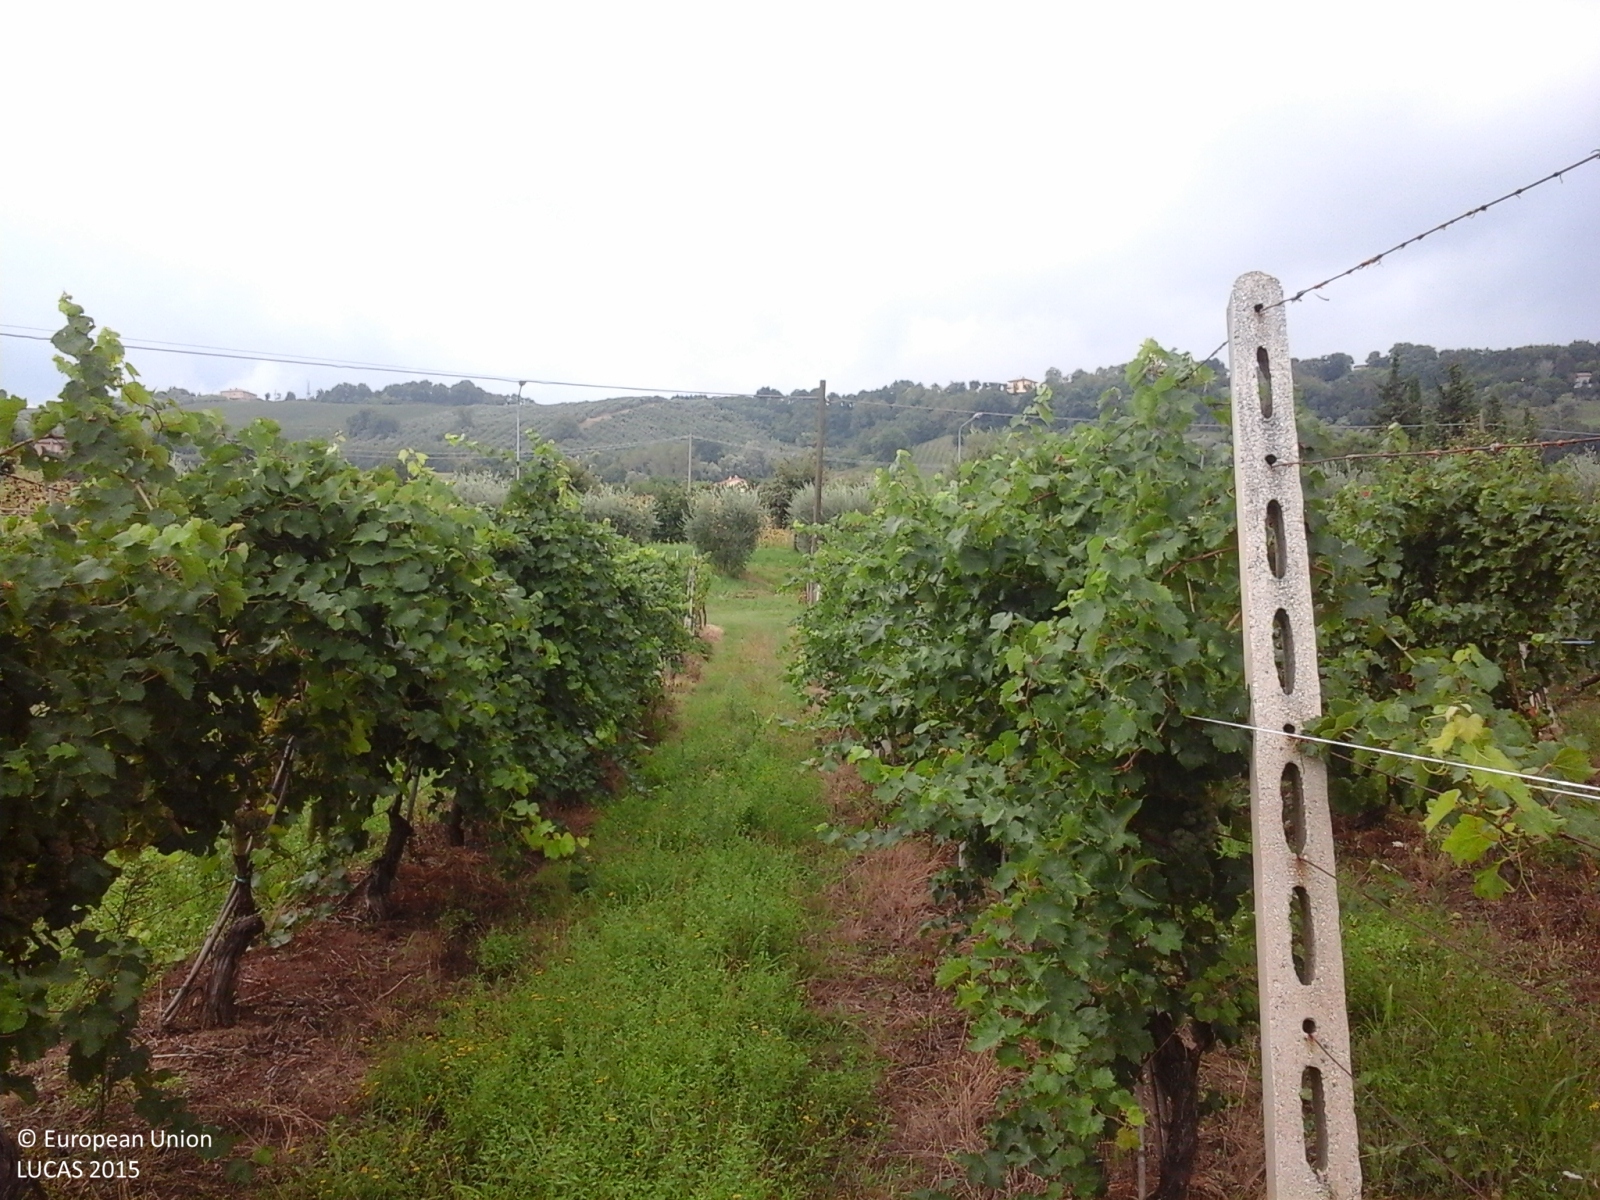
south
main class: Cropland
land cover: Vineyards
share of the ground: 50 - 75 %
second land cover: Spontaneously vegetated surfaces
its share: > 75 %
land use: Agriculture (excluding fallow land and kitchen gardens)
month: August
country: IT
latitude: 43.4536
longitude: 13.1680
